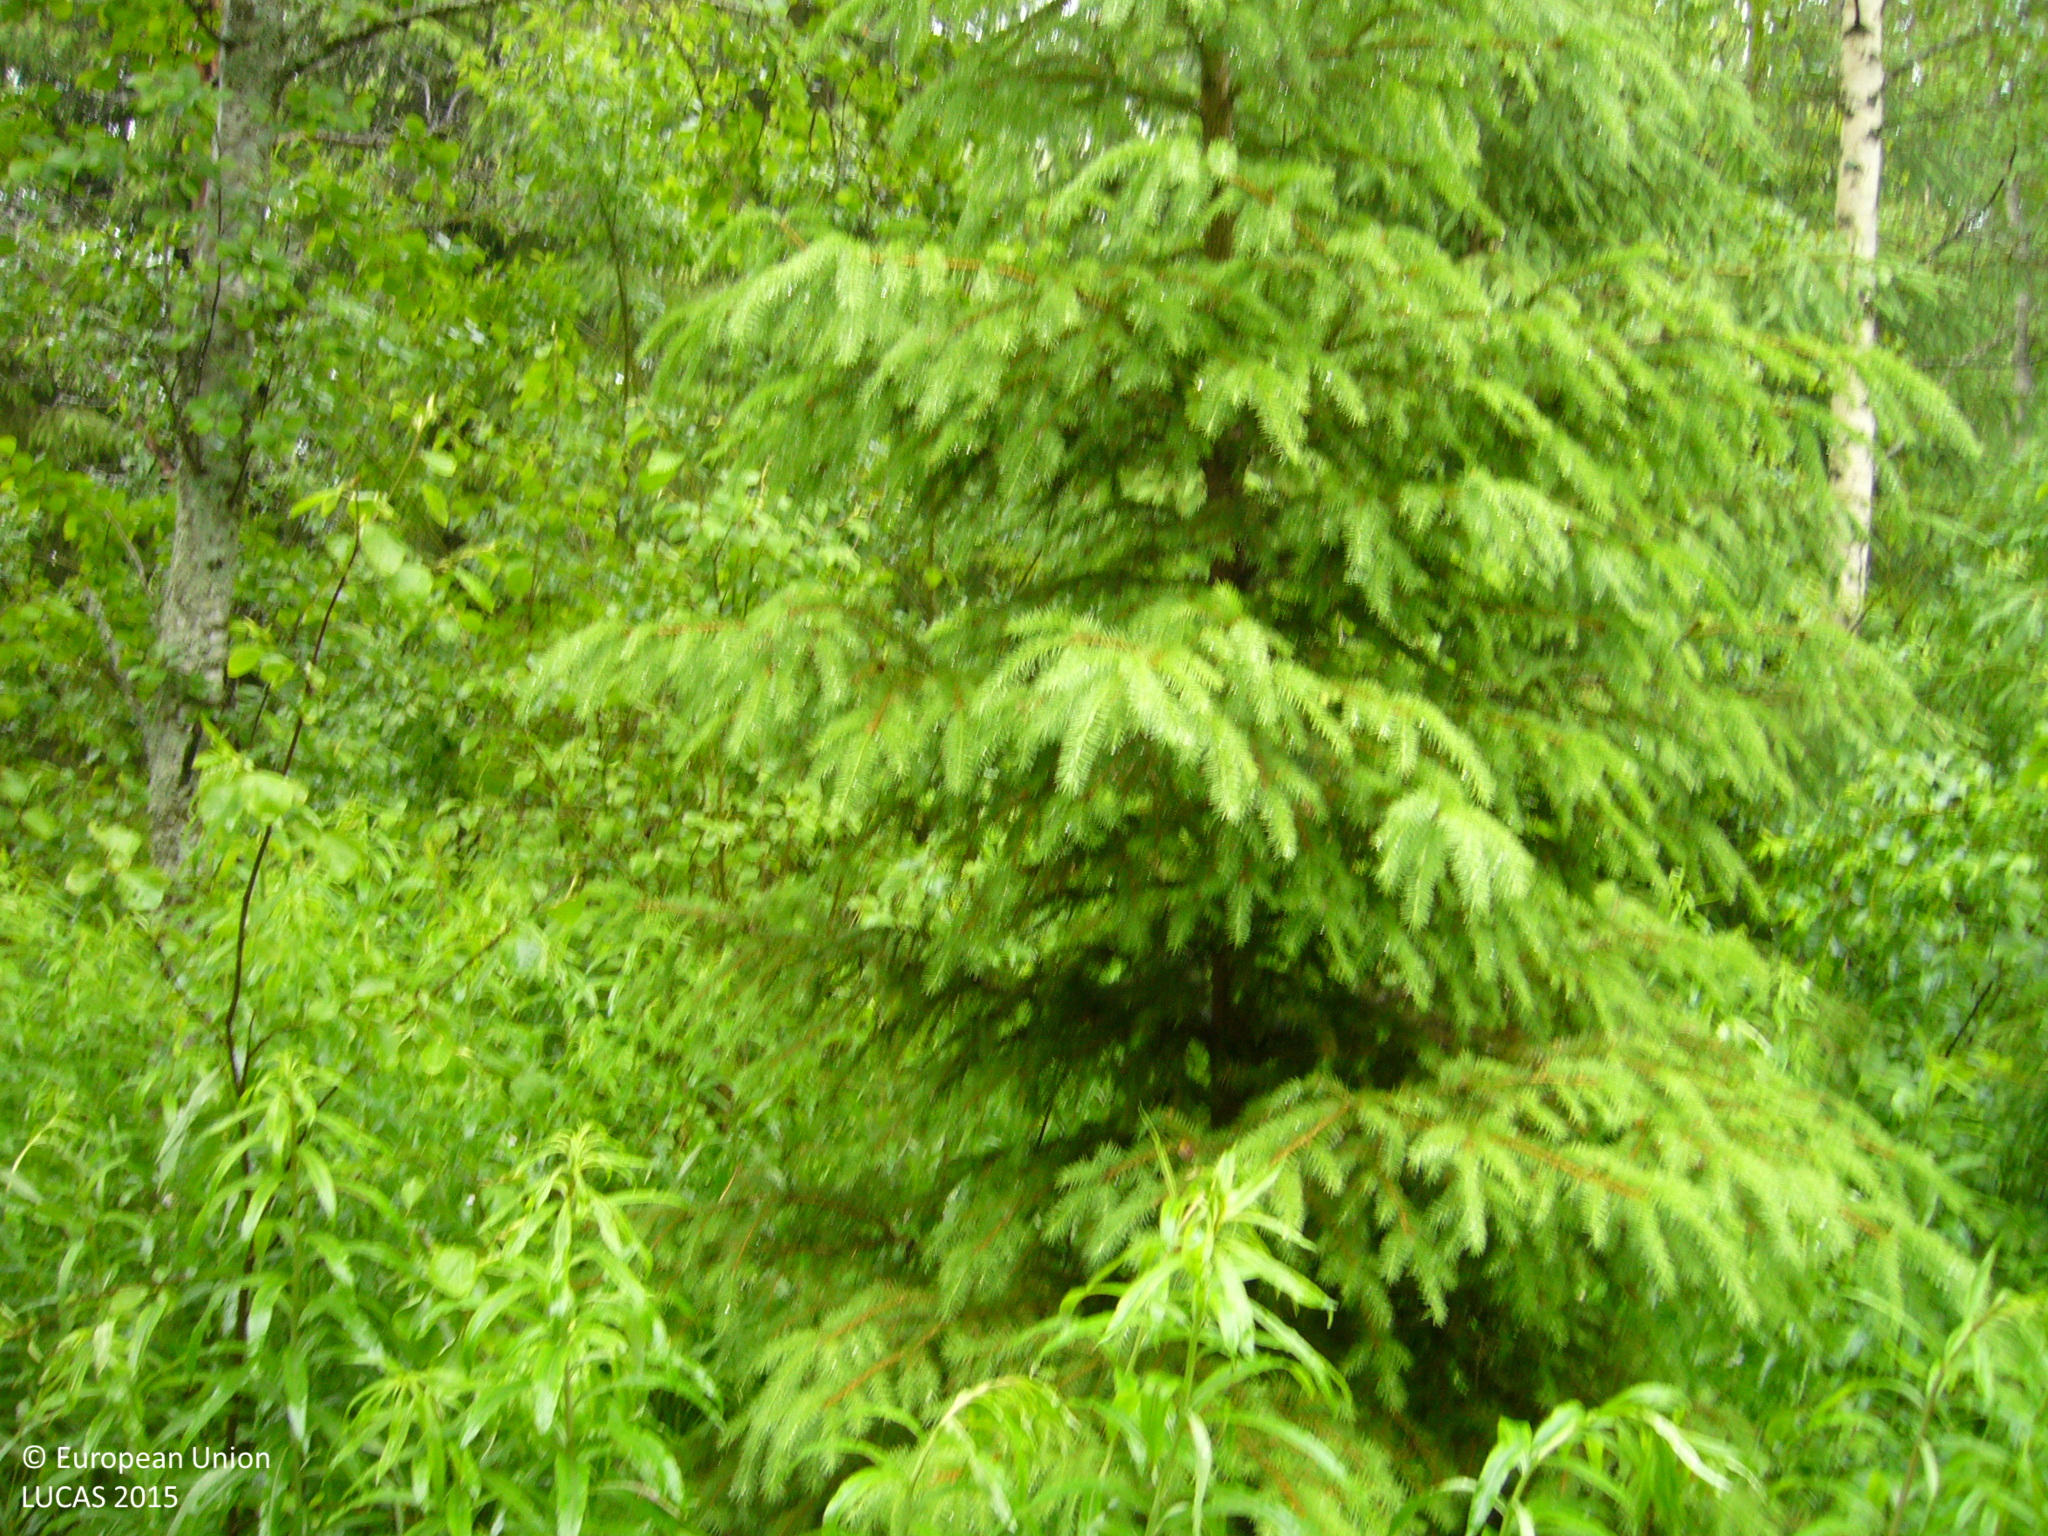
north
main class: Woodland
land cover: Other mixed woodland
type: boreal forest
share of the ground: > 75 %
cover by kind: broadleaved forest trees 50 %, coniferous forest trees 30 %, shrubs 20 %
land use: Forestry
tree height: > 5 m
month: June
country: FI
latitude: 63.6610
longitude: 26.0935
